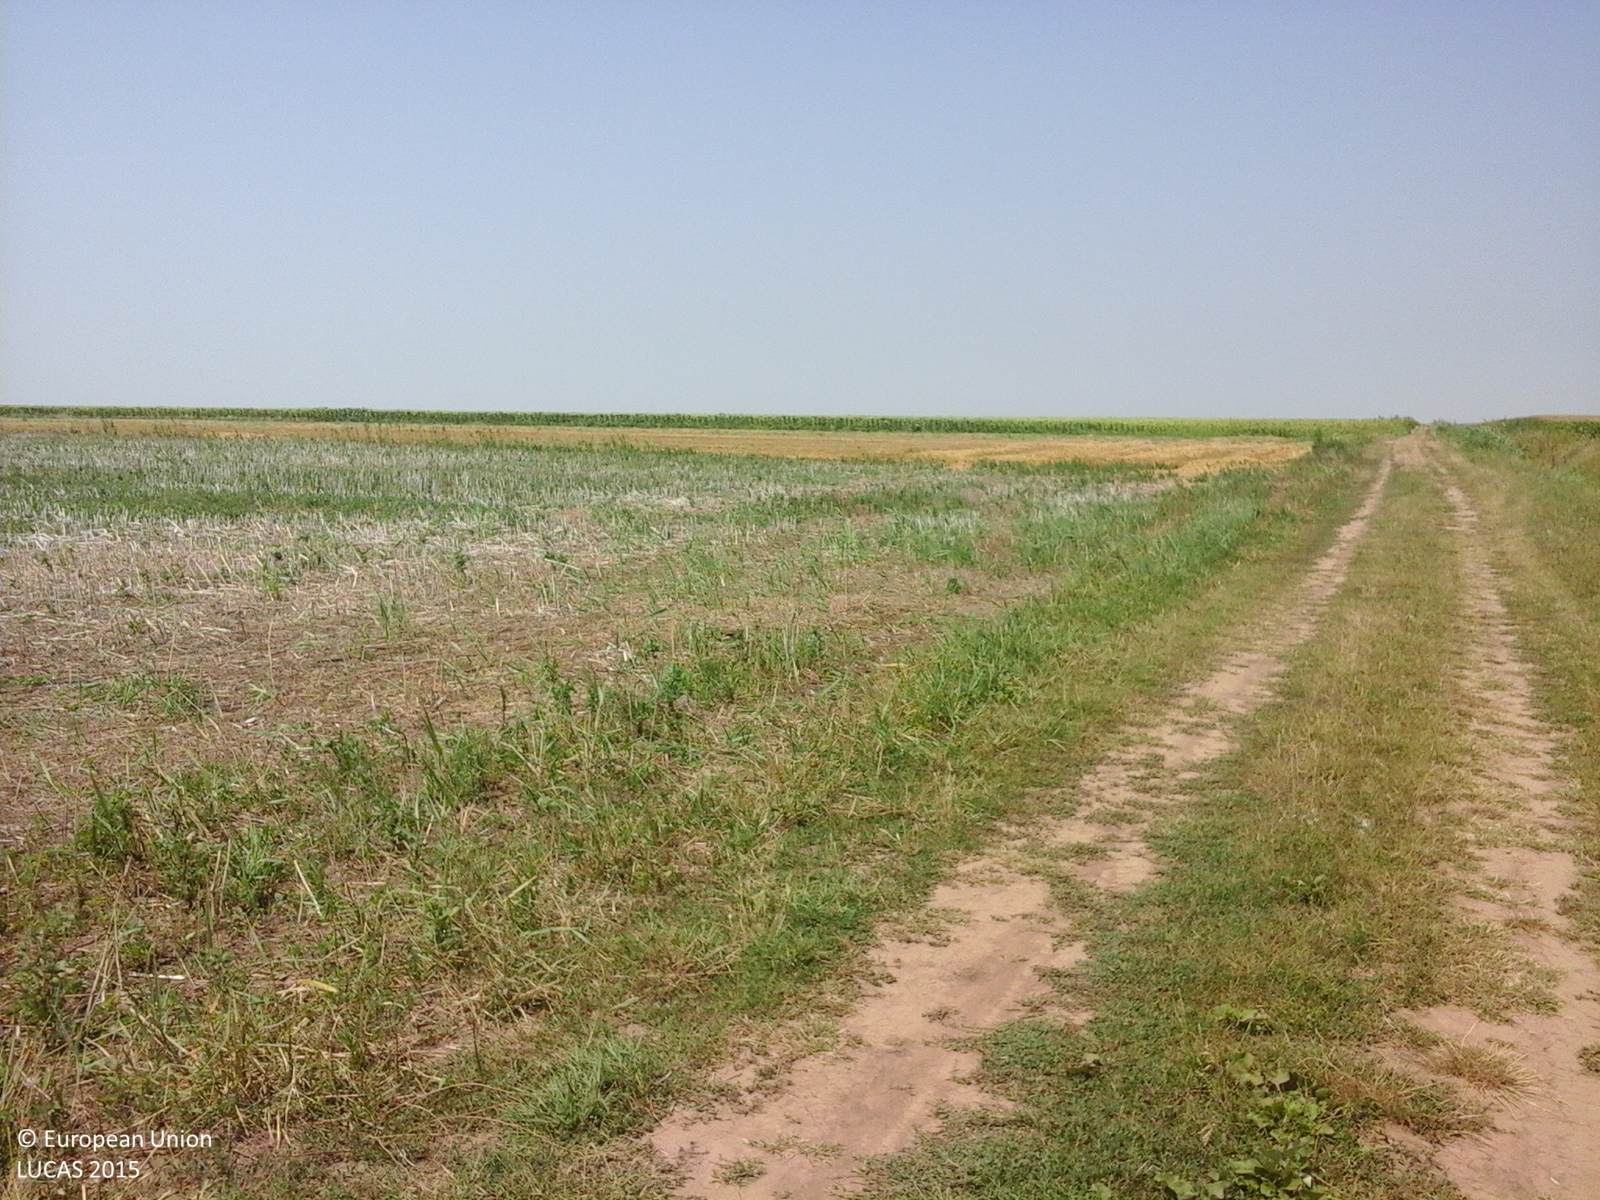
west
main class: Cropland
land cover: Maize
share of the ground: > 75 %
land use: Agriculture (excluding fallow land and kitchen gardens)
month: July
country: RO
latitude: 44.7818
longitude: 26.8478
